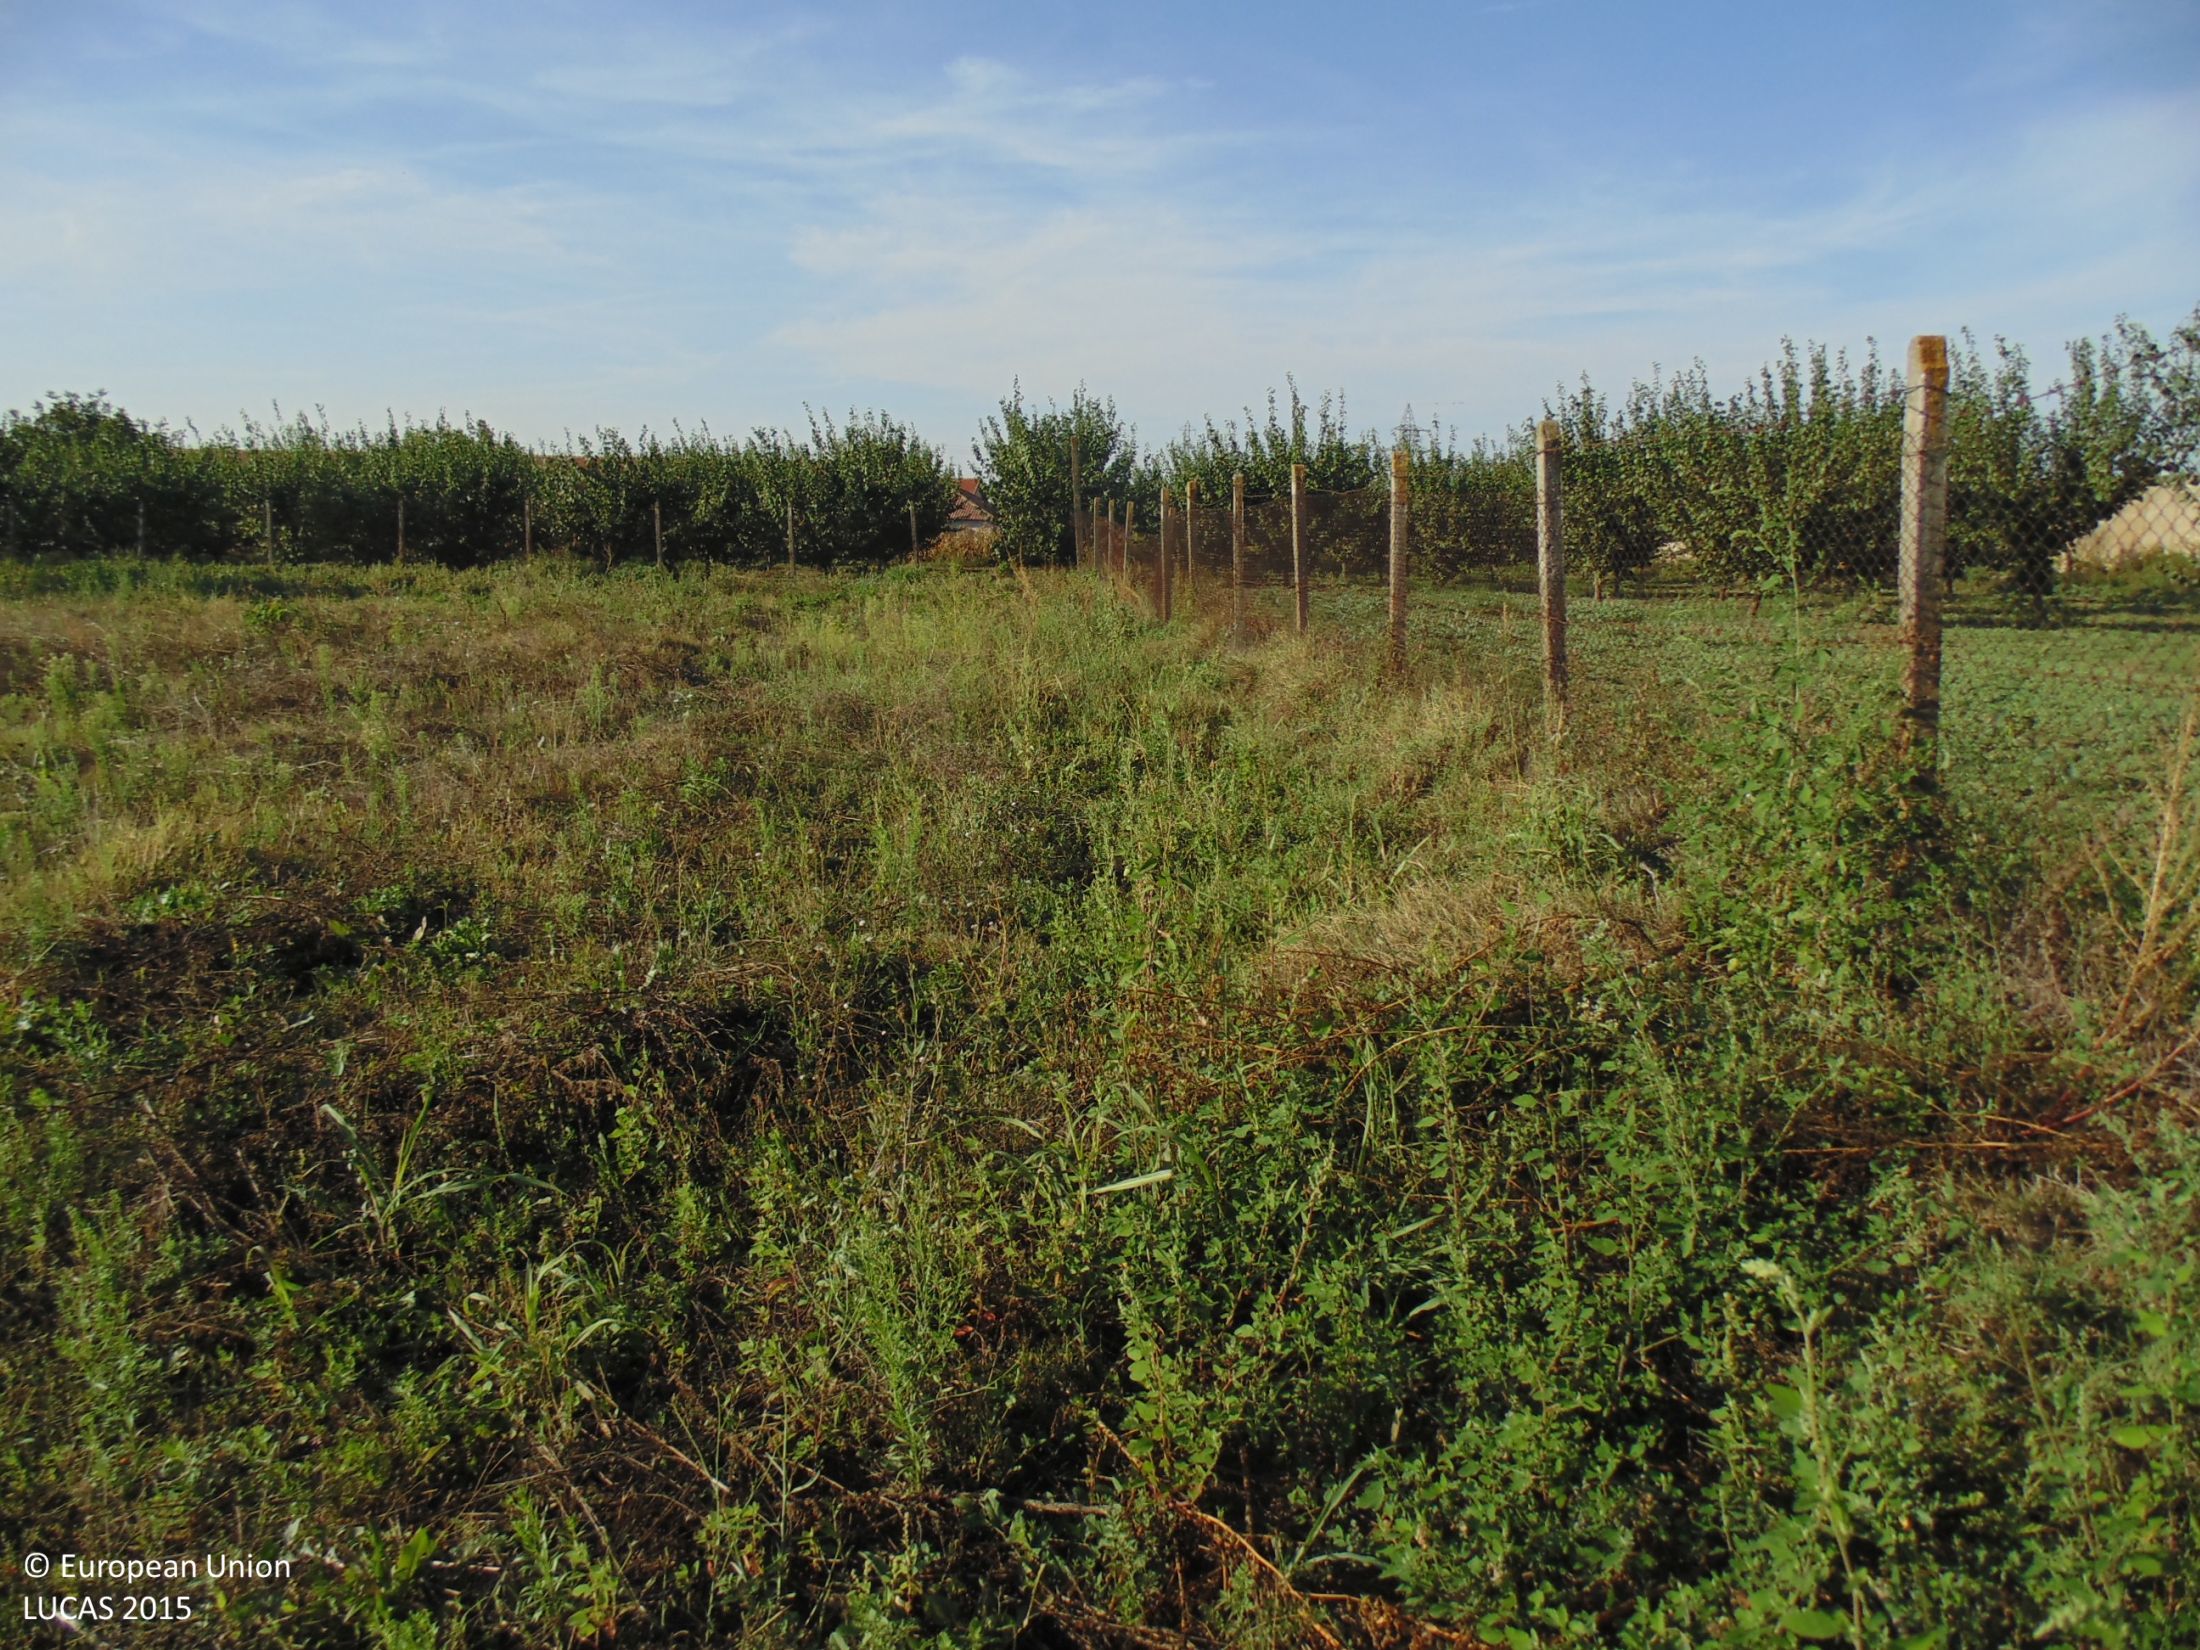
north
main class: Grassland
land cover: Grassland with sparse tree/shrub cover
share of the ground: > 75 %
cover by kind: herbaceous plants 95 %, broadleaved forest trees 5 %
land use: Semi-natural and natural areas not in use
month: September
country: BG
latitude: 44.0623
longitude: 26.8613
